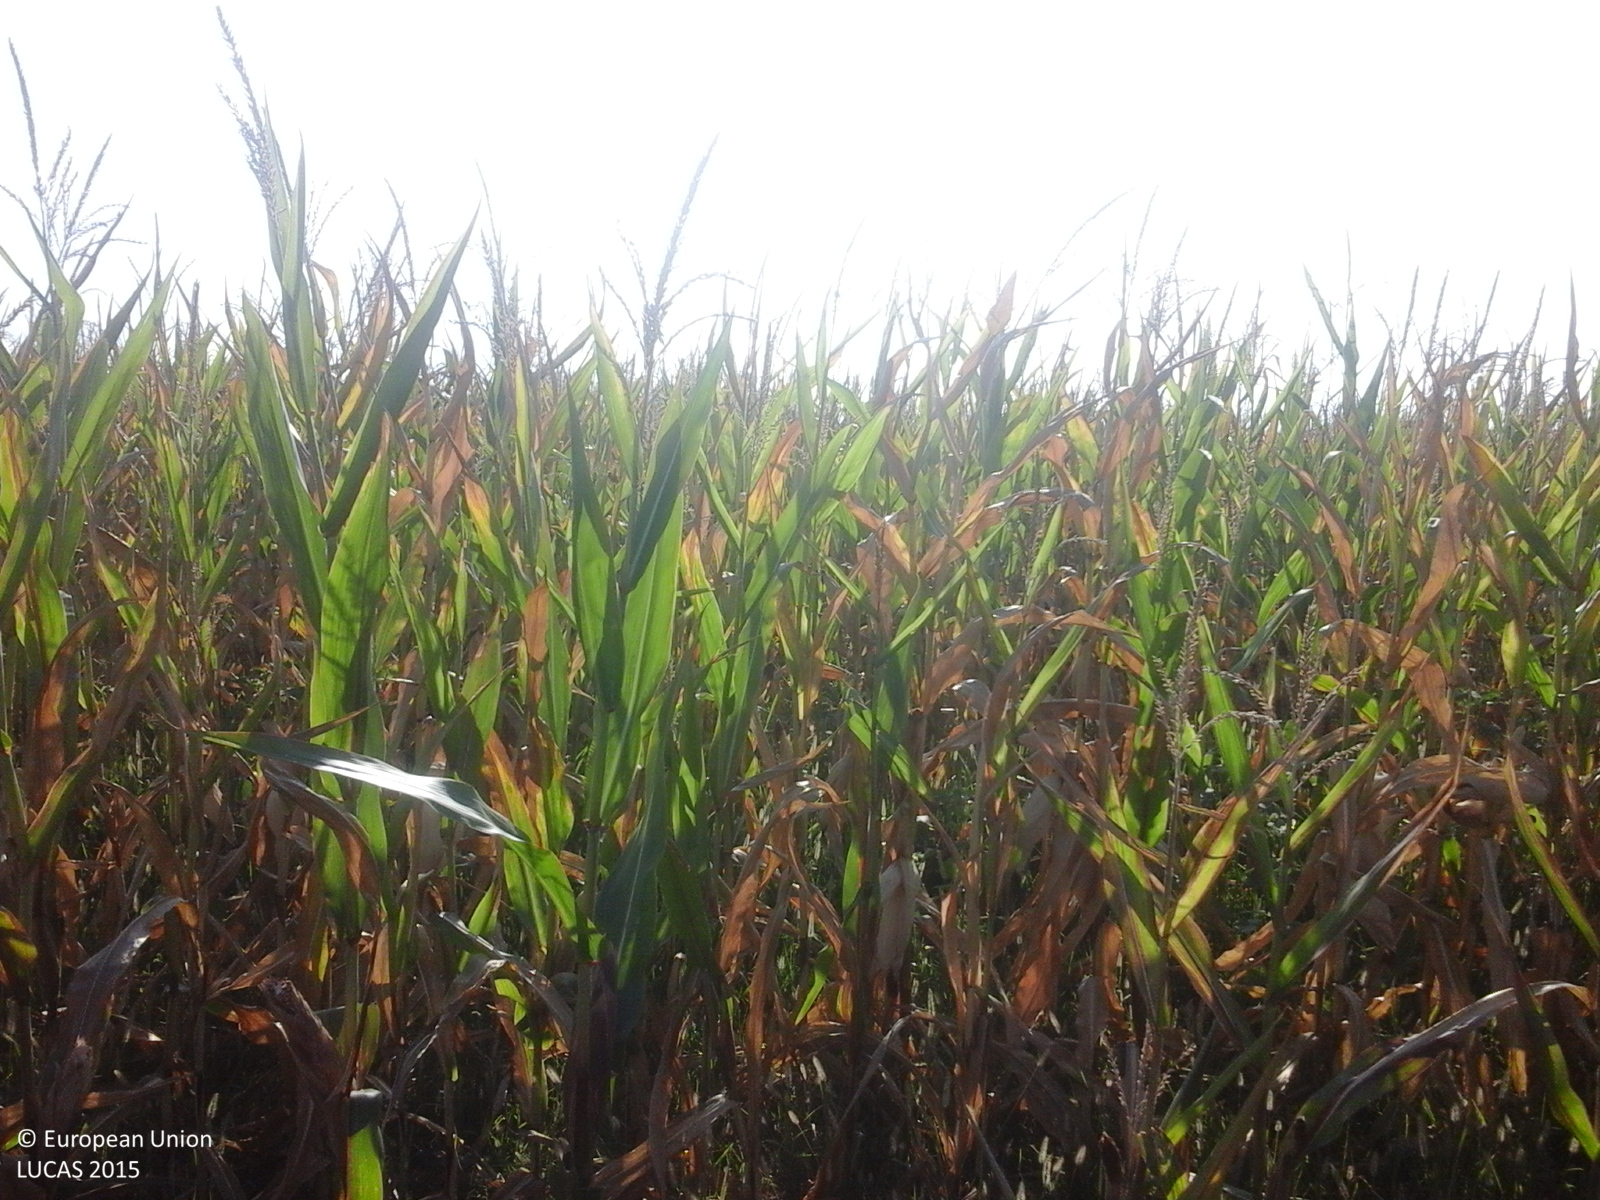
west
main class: Cropland
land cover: Maize
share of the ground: > 75 %
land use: Agriculture (excluding fallow land and kitchen gardens)
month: August
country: RO
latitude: 45.4311
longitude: 21.3939
